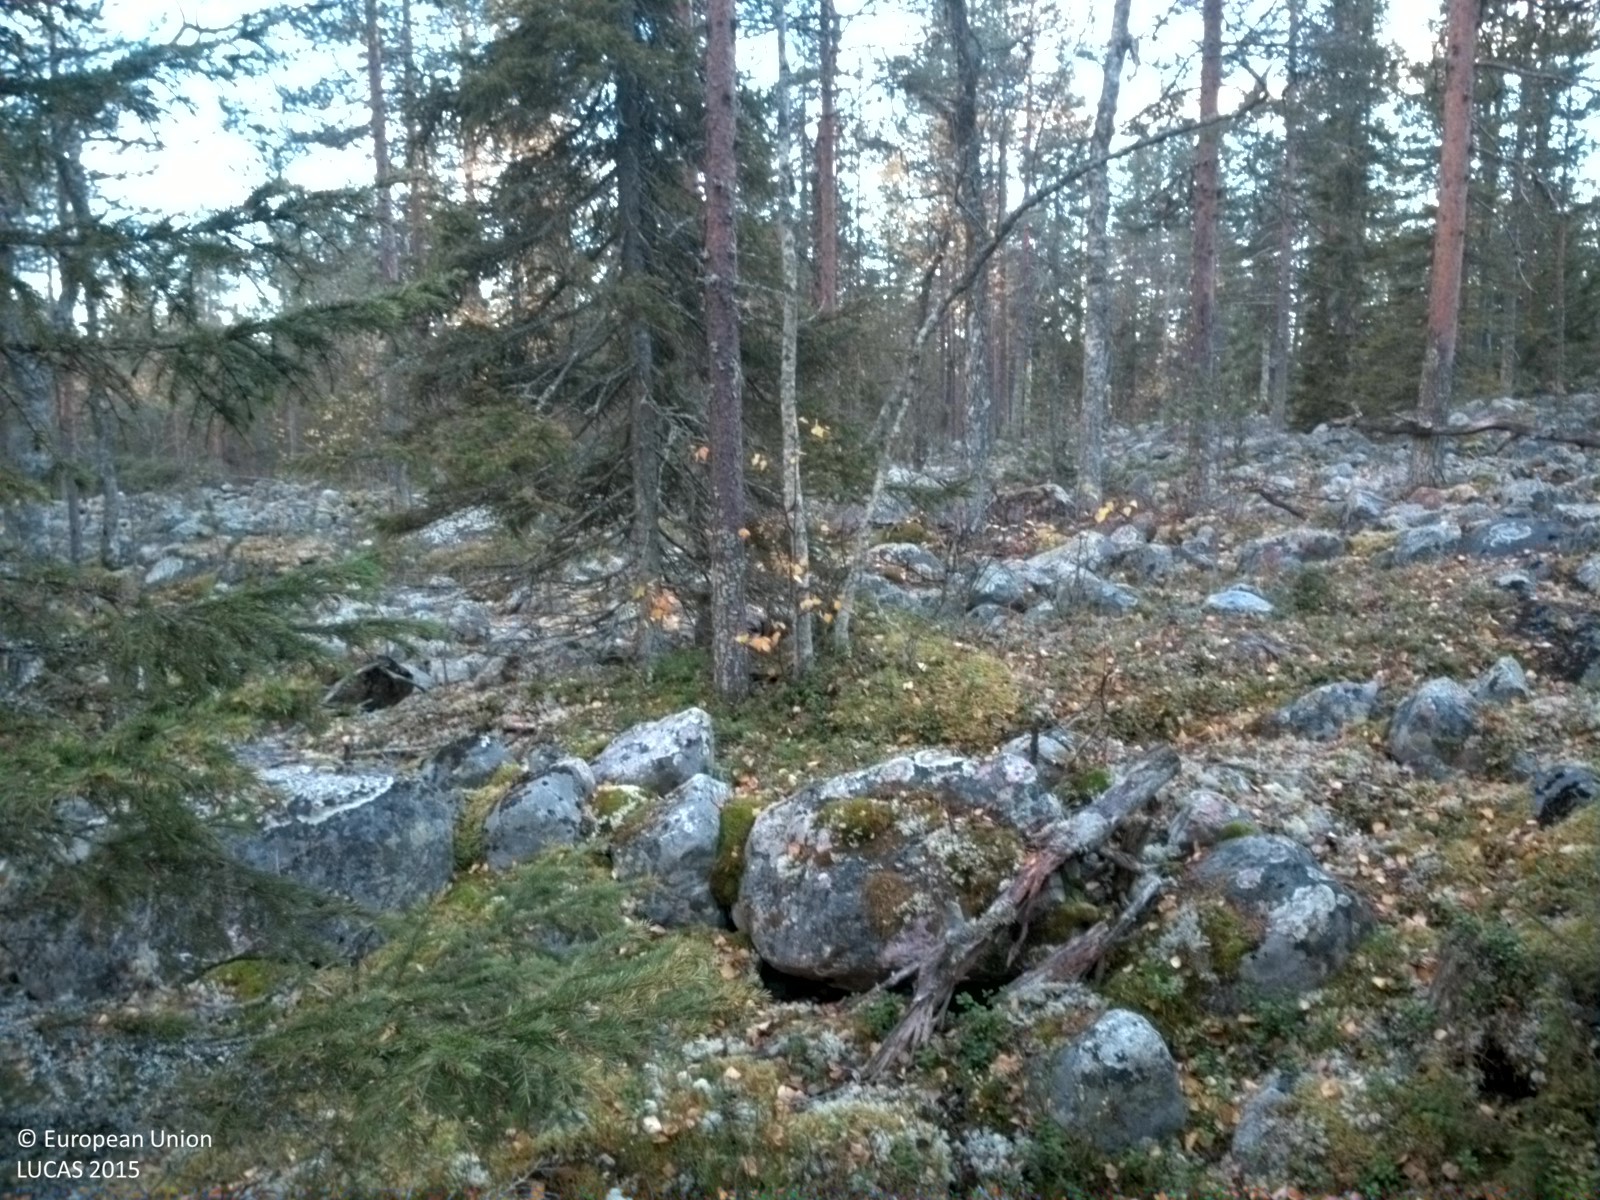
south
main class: Woodland
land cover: Pine dominated coniferous woodland
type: boreal forest
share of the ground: 25 - 50 %
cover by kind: shrubs 50 %, coniferous forest trees 30 %, lichens and mosses 10 %, consolidated bare surface 10 %
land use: Forestry
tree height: > 5 m
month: October
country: SE
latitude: 65.9891
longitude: 22.0649
